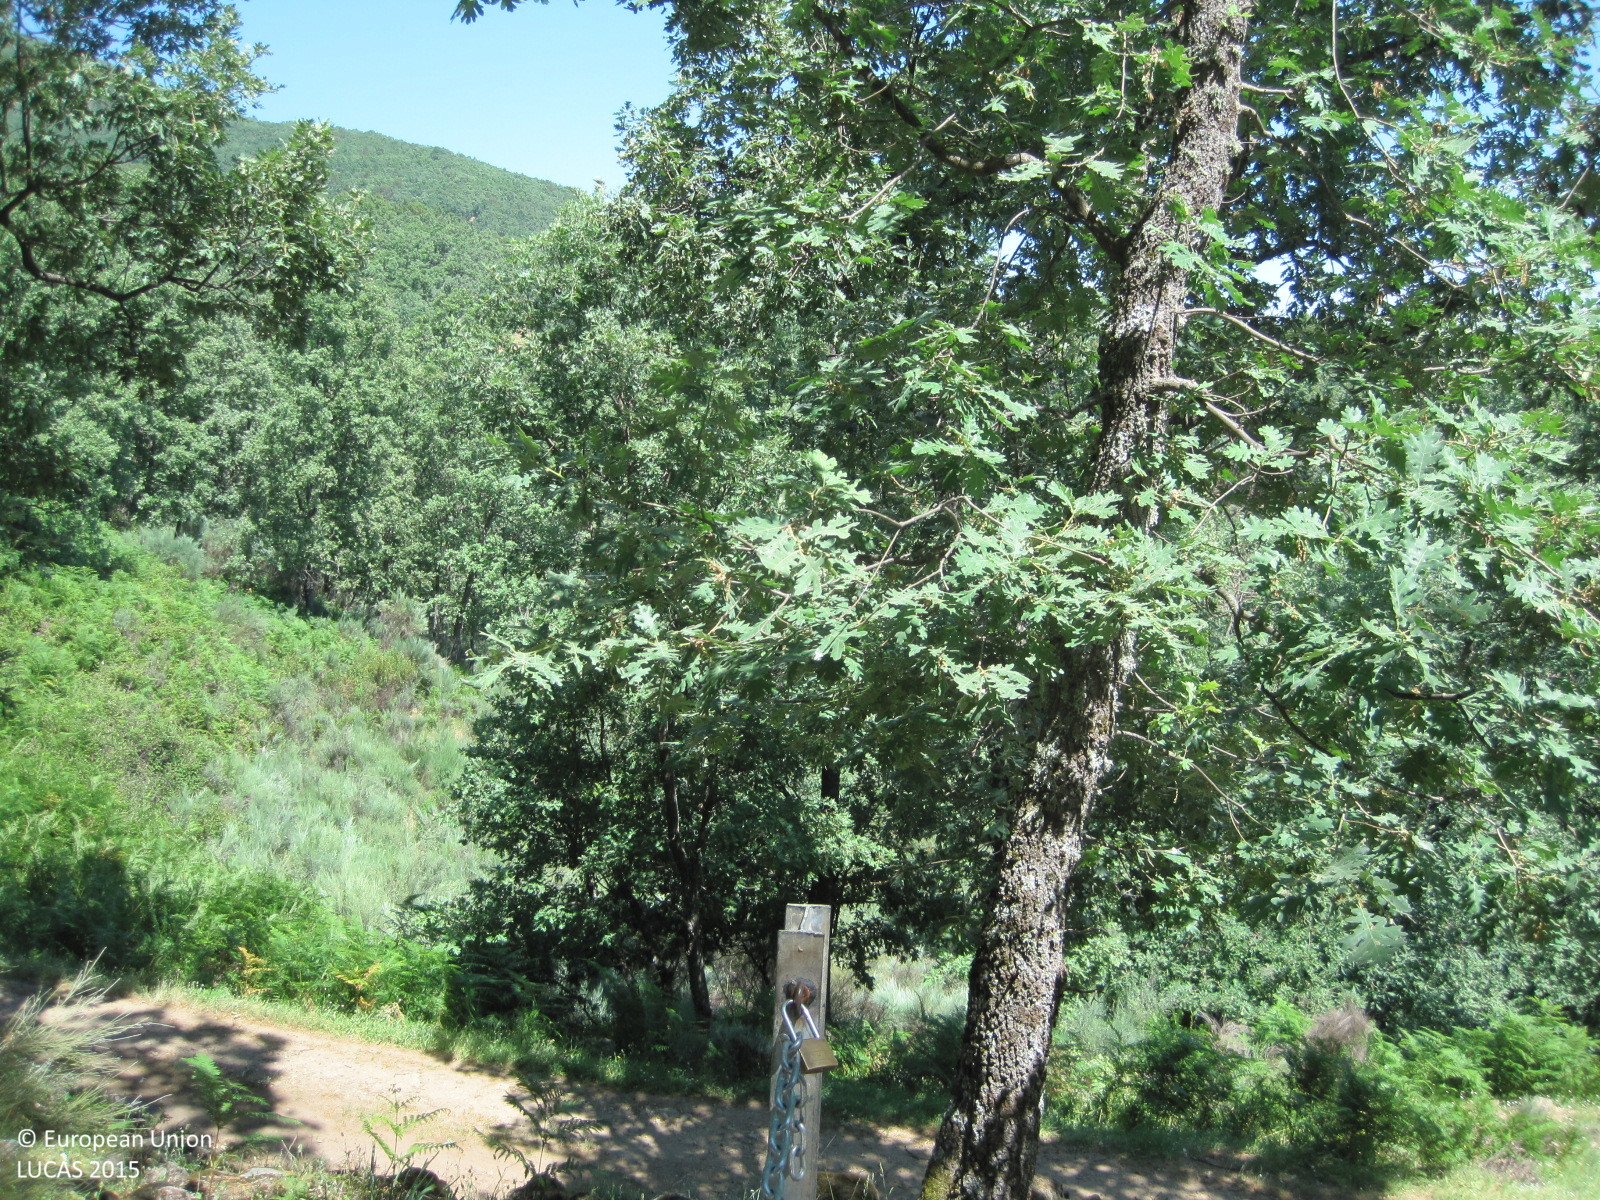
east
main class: Shrubland
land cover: Shrubland with sparse tree cover
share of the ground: > 75 %
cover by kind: shrubs 95 %, broadleaved forest trees 5 %
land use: Semi-natural and natural areas not in use
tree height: < 5 m
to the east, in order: Shrubland with sparse tree cover; Tracks; Shrubland with sparse tree cover; Dry stone walls; Broadleaved woodland; Dry stone walls; Shrubland without tree cover; Rivers and streams; Shrubland without tree cover; Dry stone walls; Pine dominated coniferous woodland
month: May
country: ES
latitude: 40.1783
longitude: -5.1949
